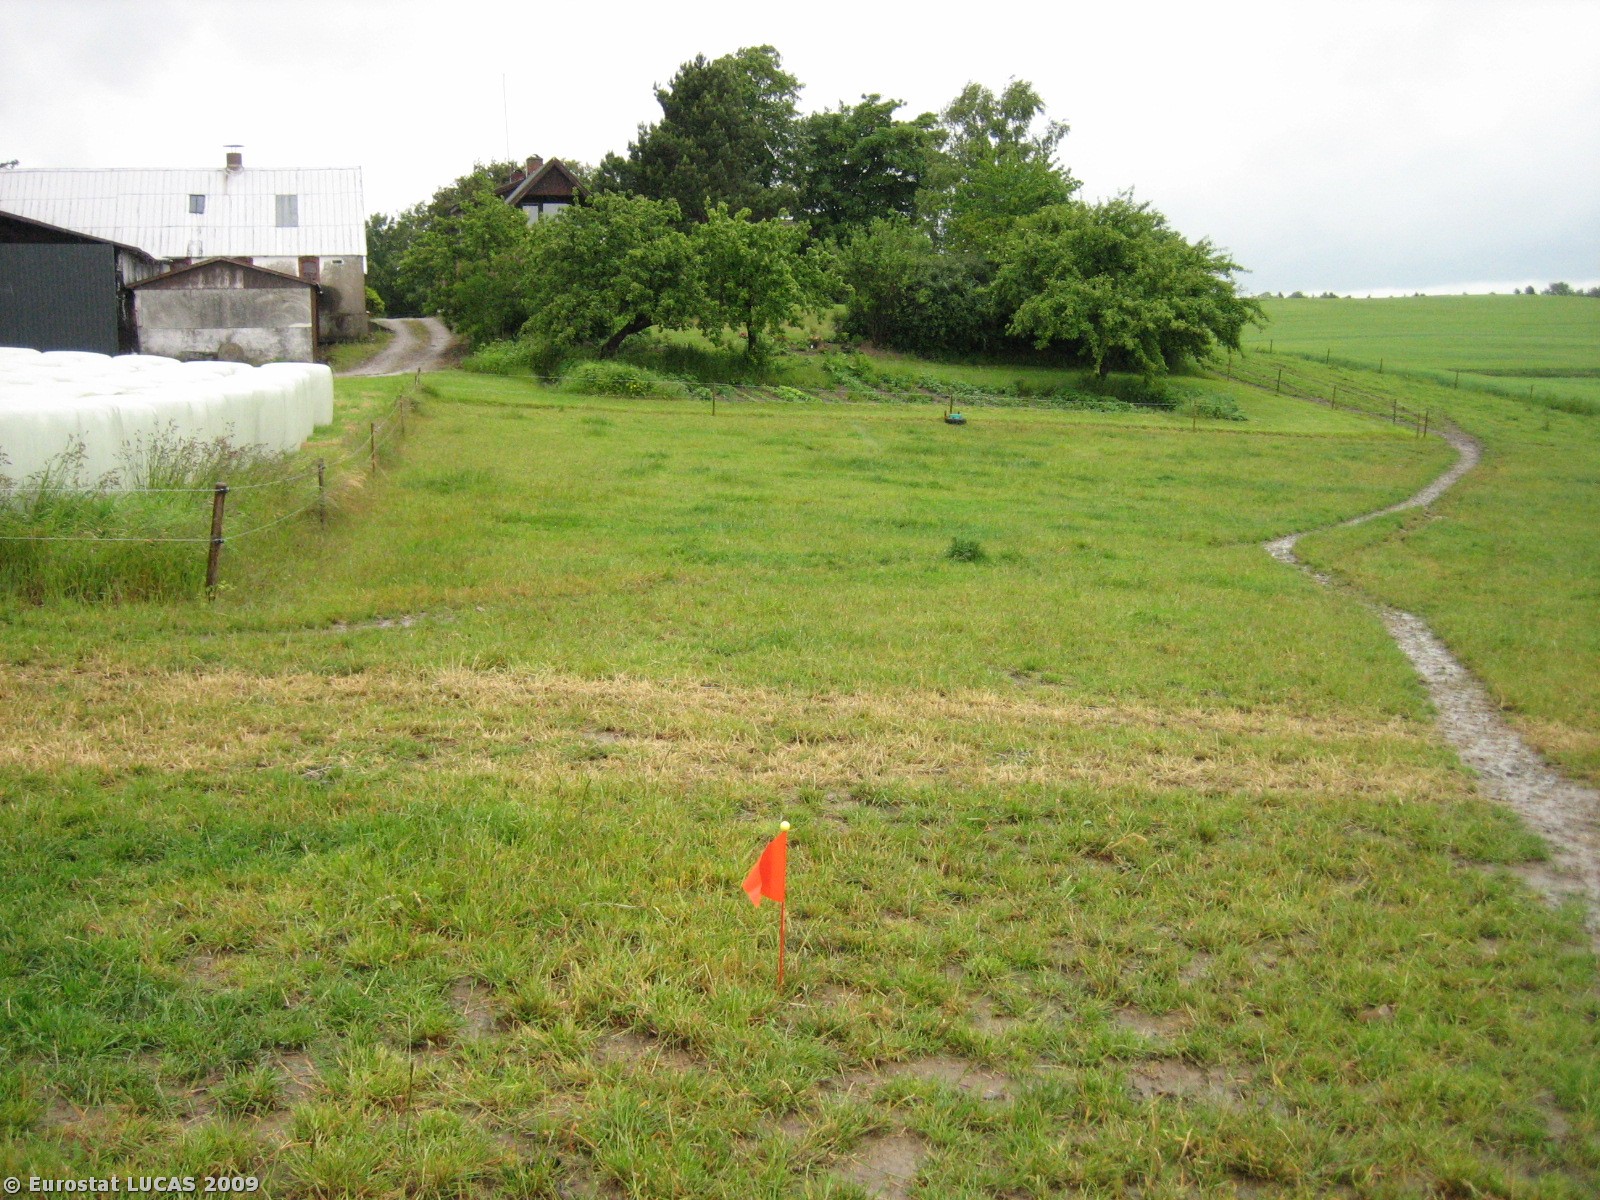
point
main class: Grassland
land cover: Grassland without tree/shrub cover
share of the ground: 50 - 75 %
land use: Agriculture (excluding fallow land and kitchen gardens)
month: June
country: DK
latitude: 56.0799
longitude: 9.9840
